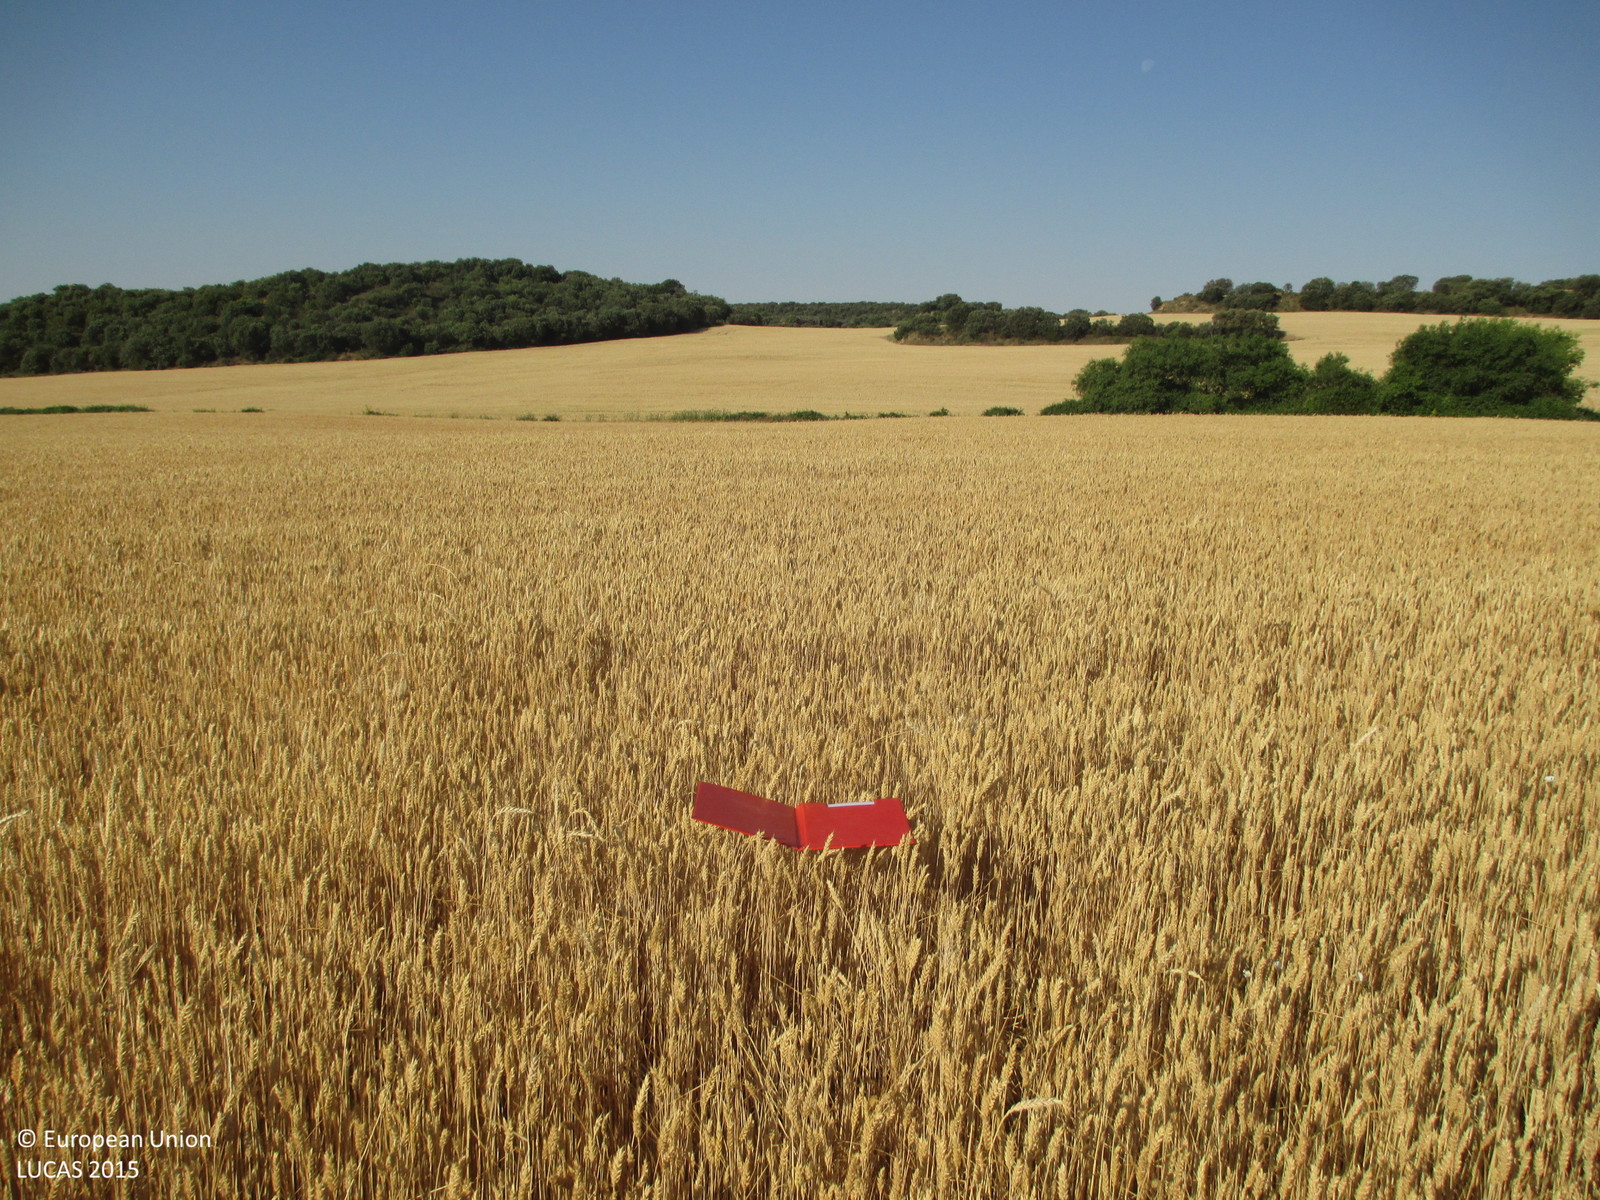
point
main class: Cropland
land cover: Common wheat
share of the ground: > 75 %
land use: Agriculture (excluding fallow land and kitchen gardens)
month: June
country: ES
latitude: 42.1512
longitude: -0.2473
